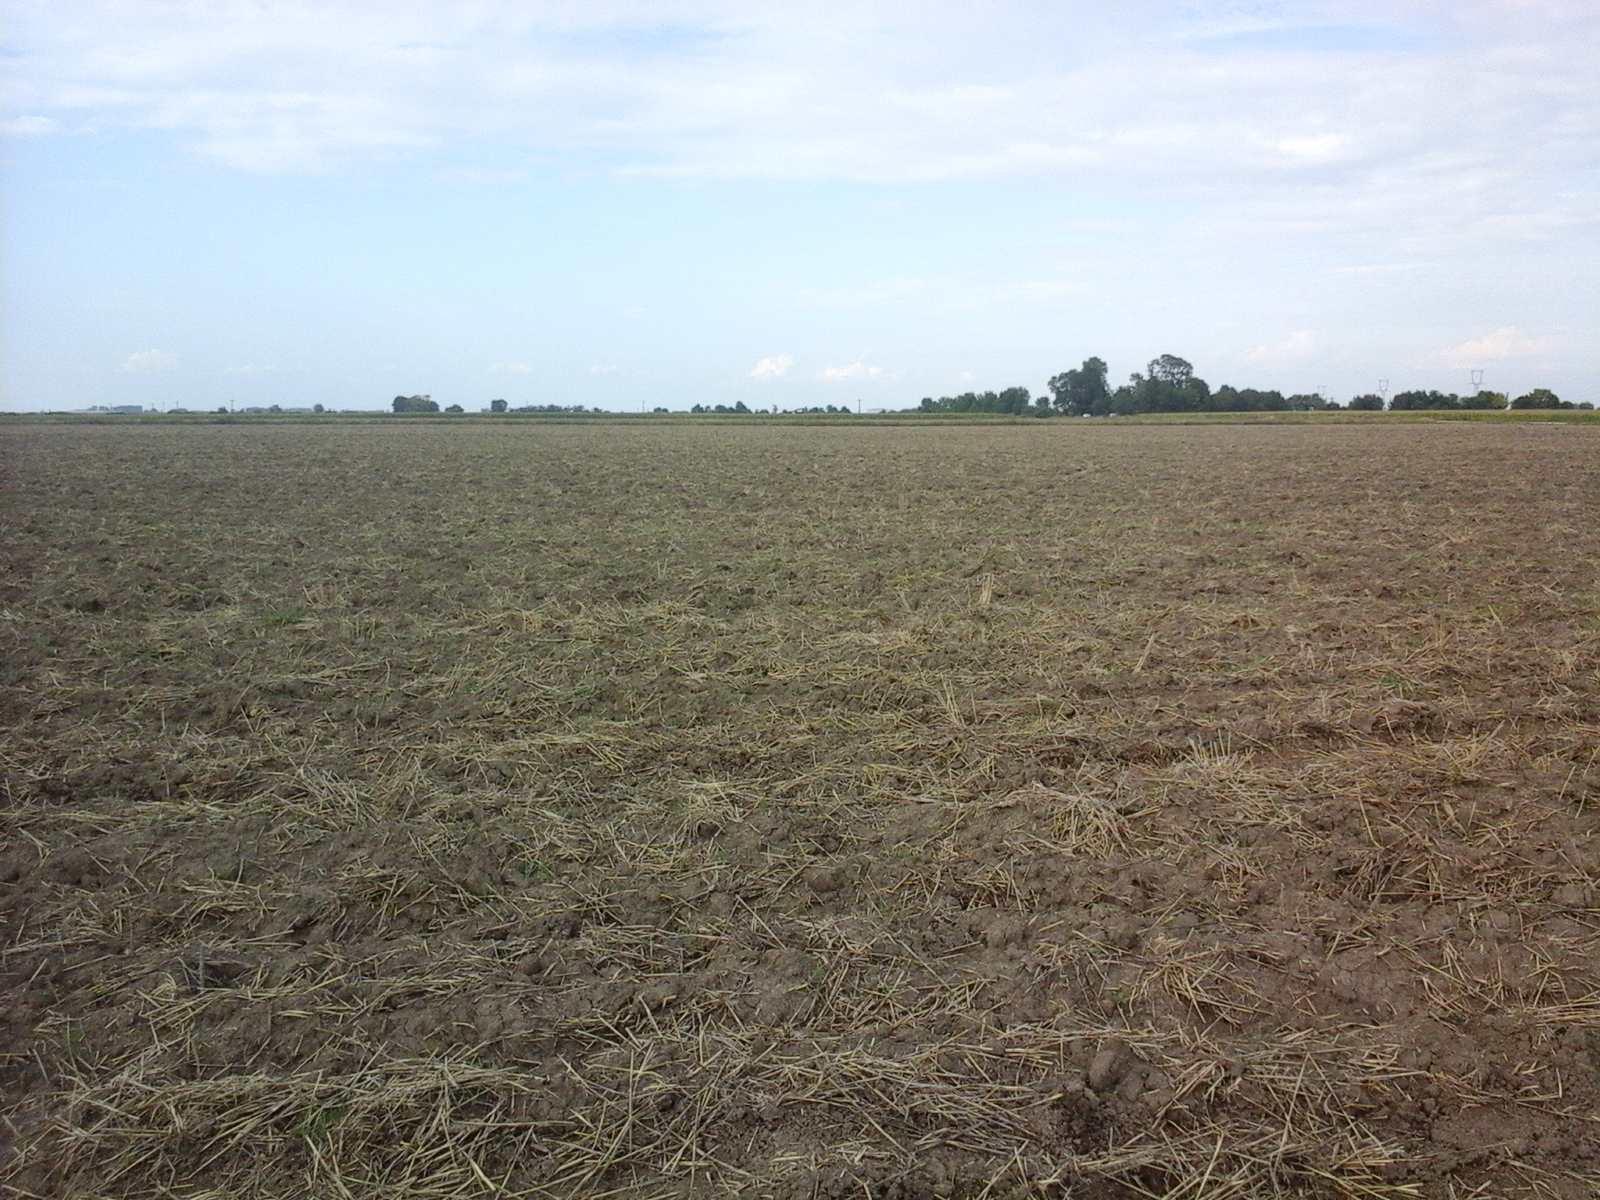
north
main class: Cropland
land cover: Common wheat
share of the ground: < 10 %
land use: Agriculture (excluding fallow land and kitchen gardens)
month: August
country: RO
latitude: 46.7310
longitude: 21.6479
